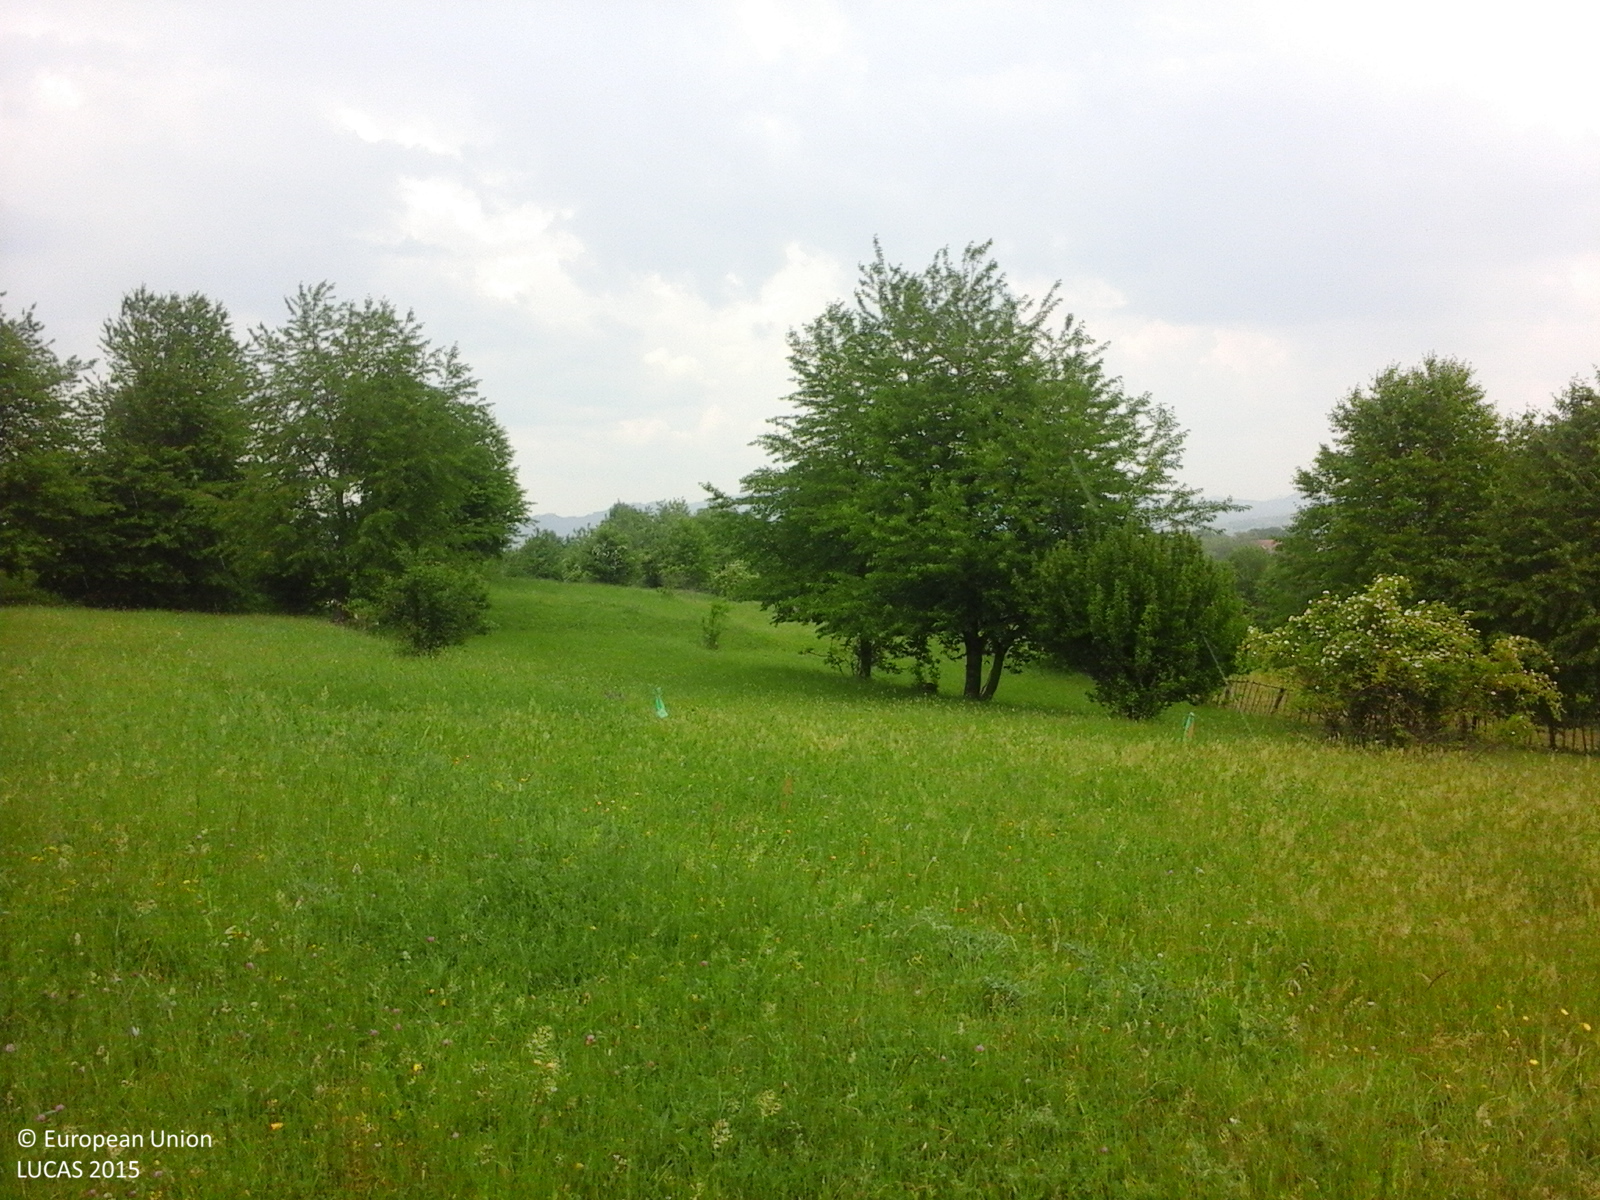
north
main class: Grassland
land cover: Grassland without tree/shrub cover
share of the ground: > 75 %
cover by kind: herbaceous plants 100 %
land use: Agriculture (excluding fallow land and kitchen gardens)
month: June
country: RO
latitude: 46.3846
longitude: 26.4771
